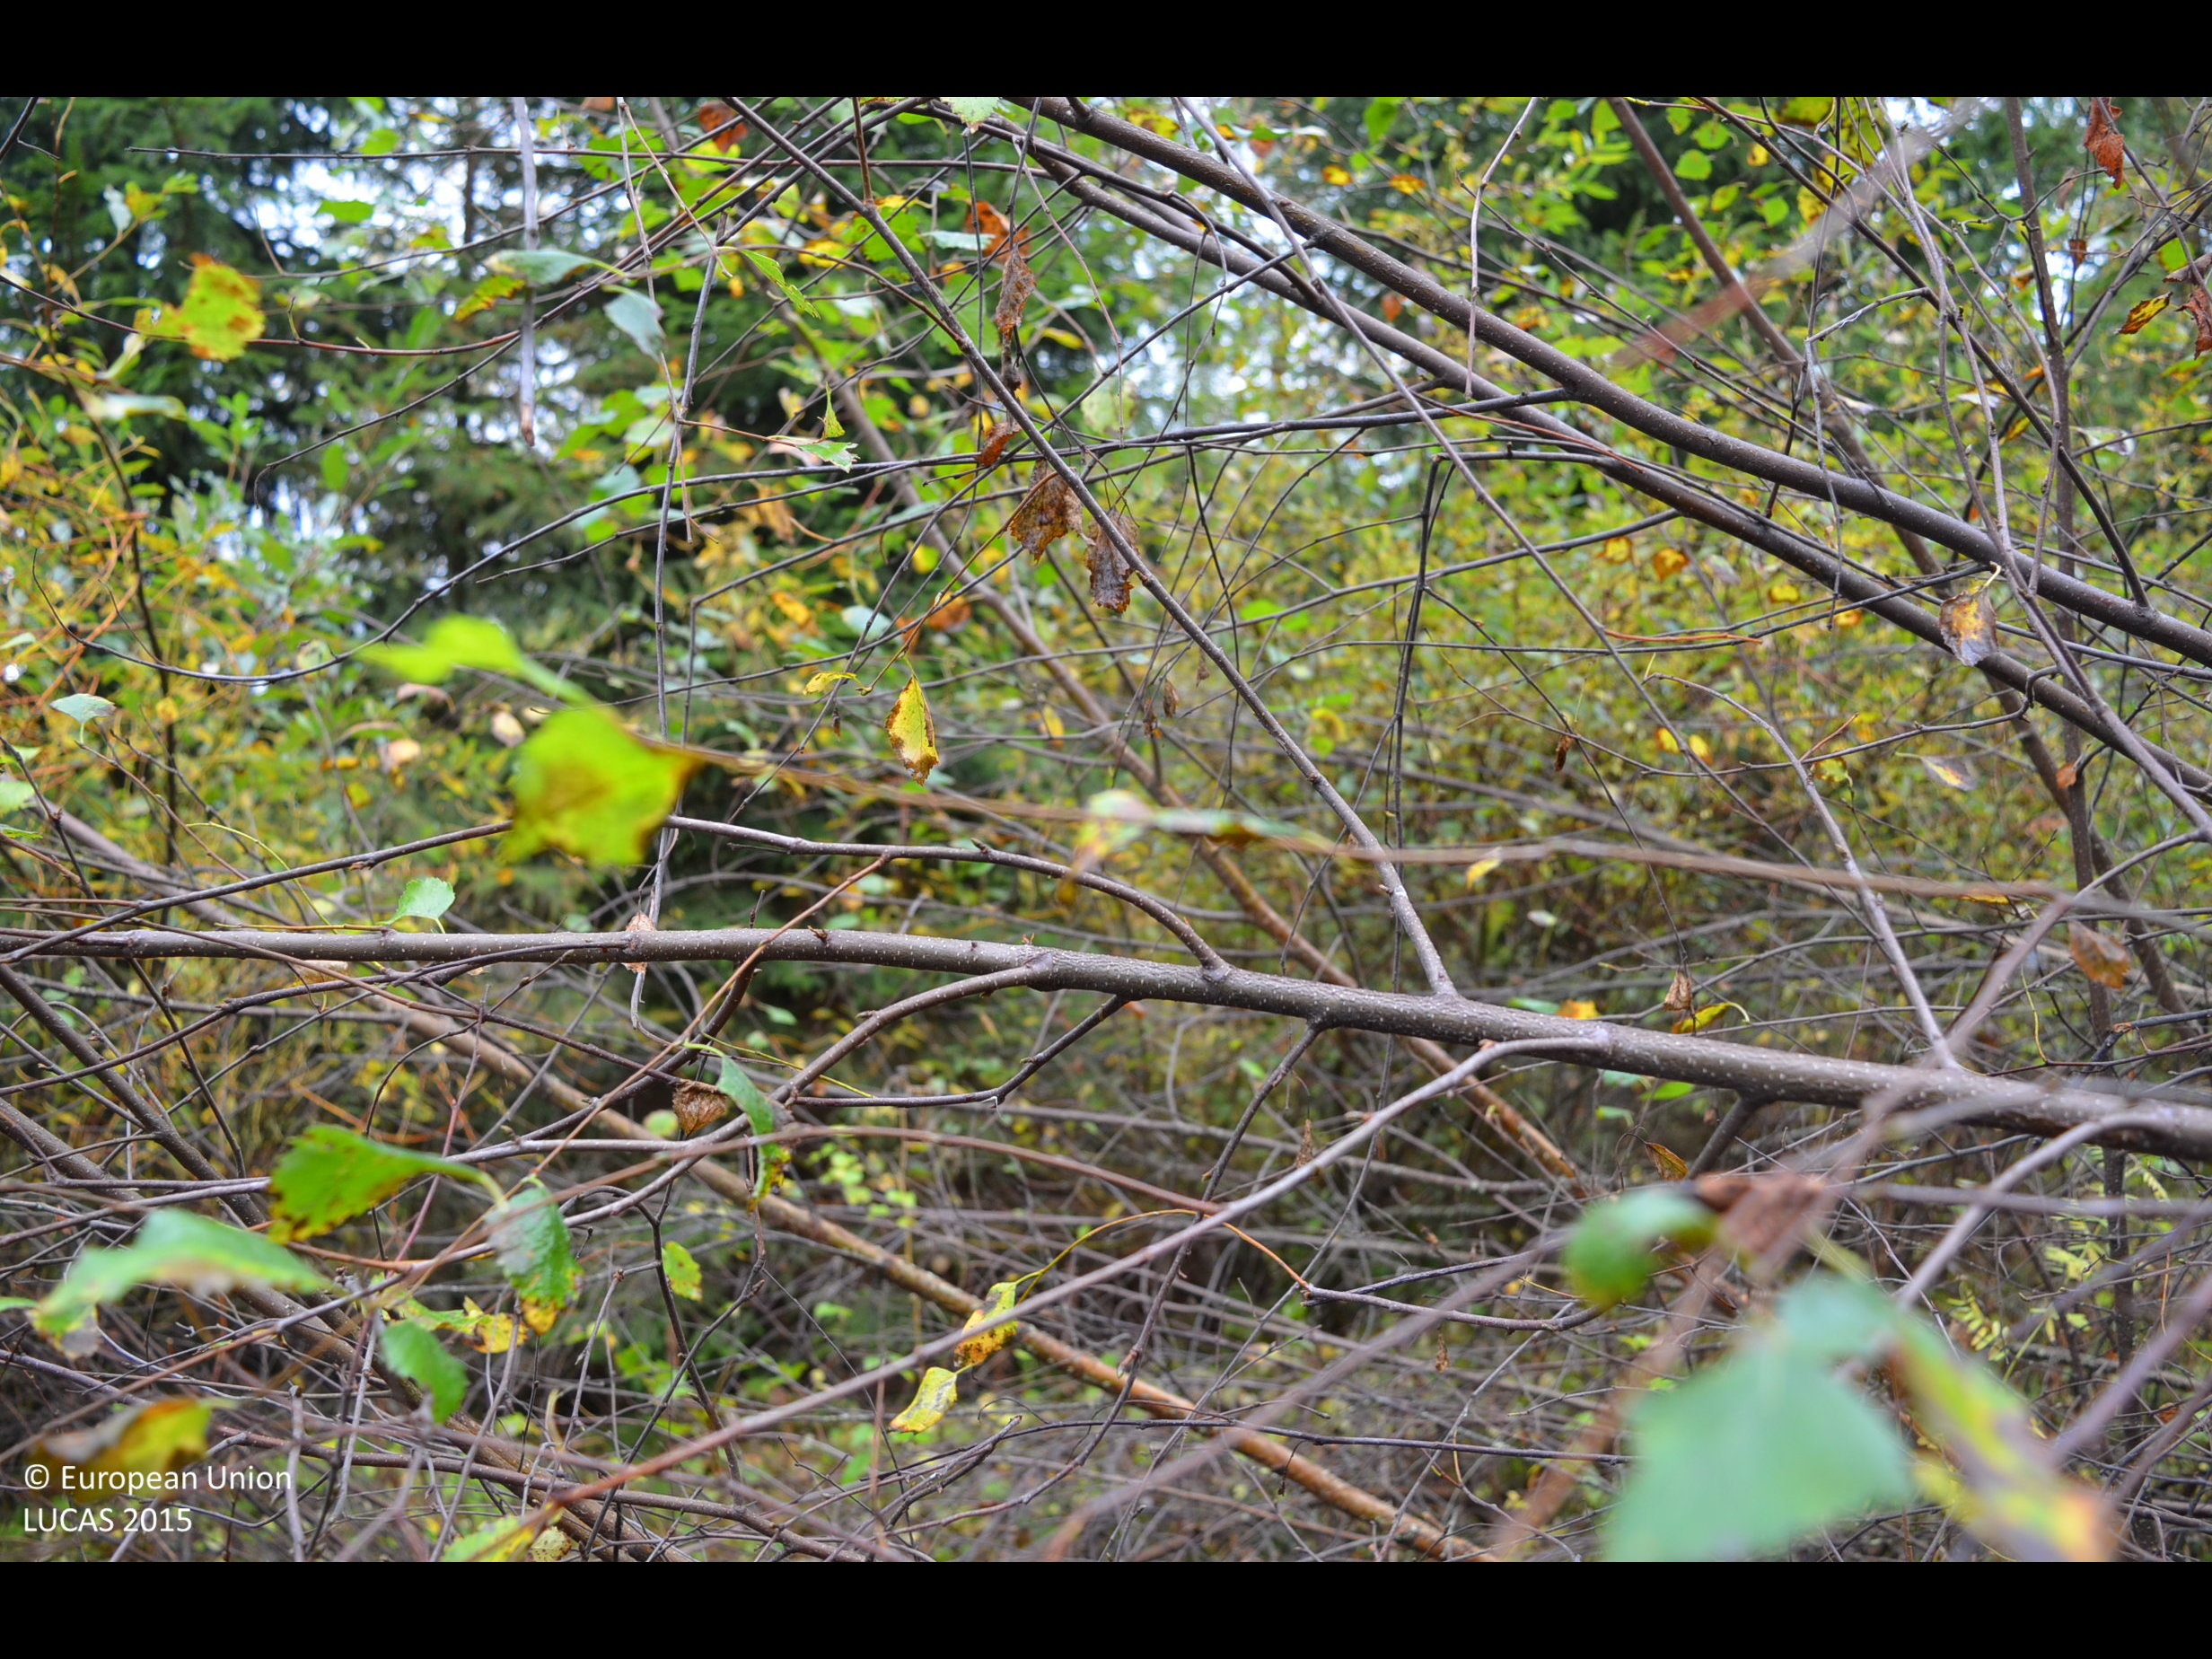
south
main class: Woodland
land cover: Broadleaved woodland
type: boreal forest
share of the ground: > 75 %
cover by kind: broadleaved forest trees 80 %, coniferous forest trees 15 %, shrubs 5 %
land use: Forestry
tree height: < 5 m
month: September
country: FI
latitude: 62.6881
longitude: 23.8083
